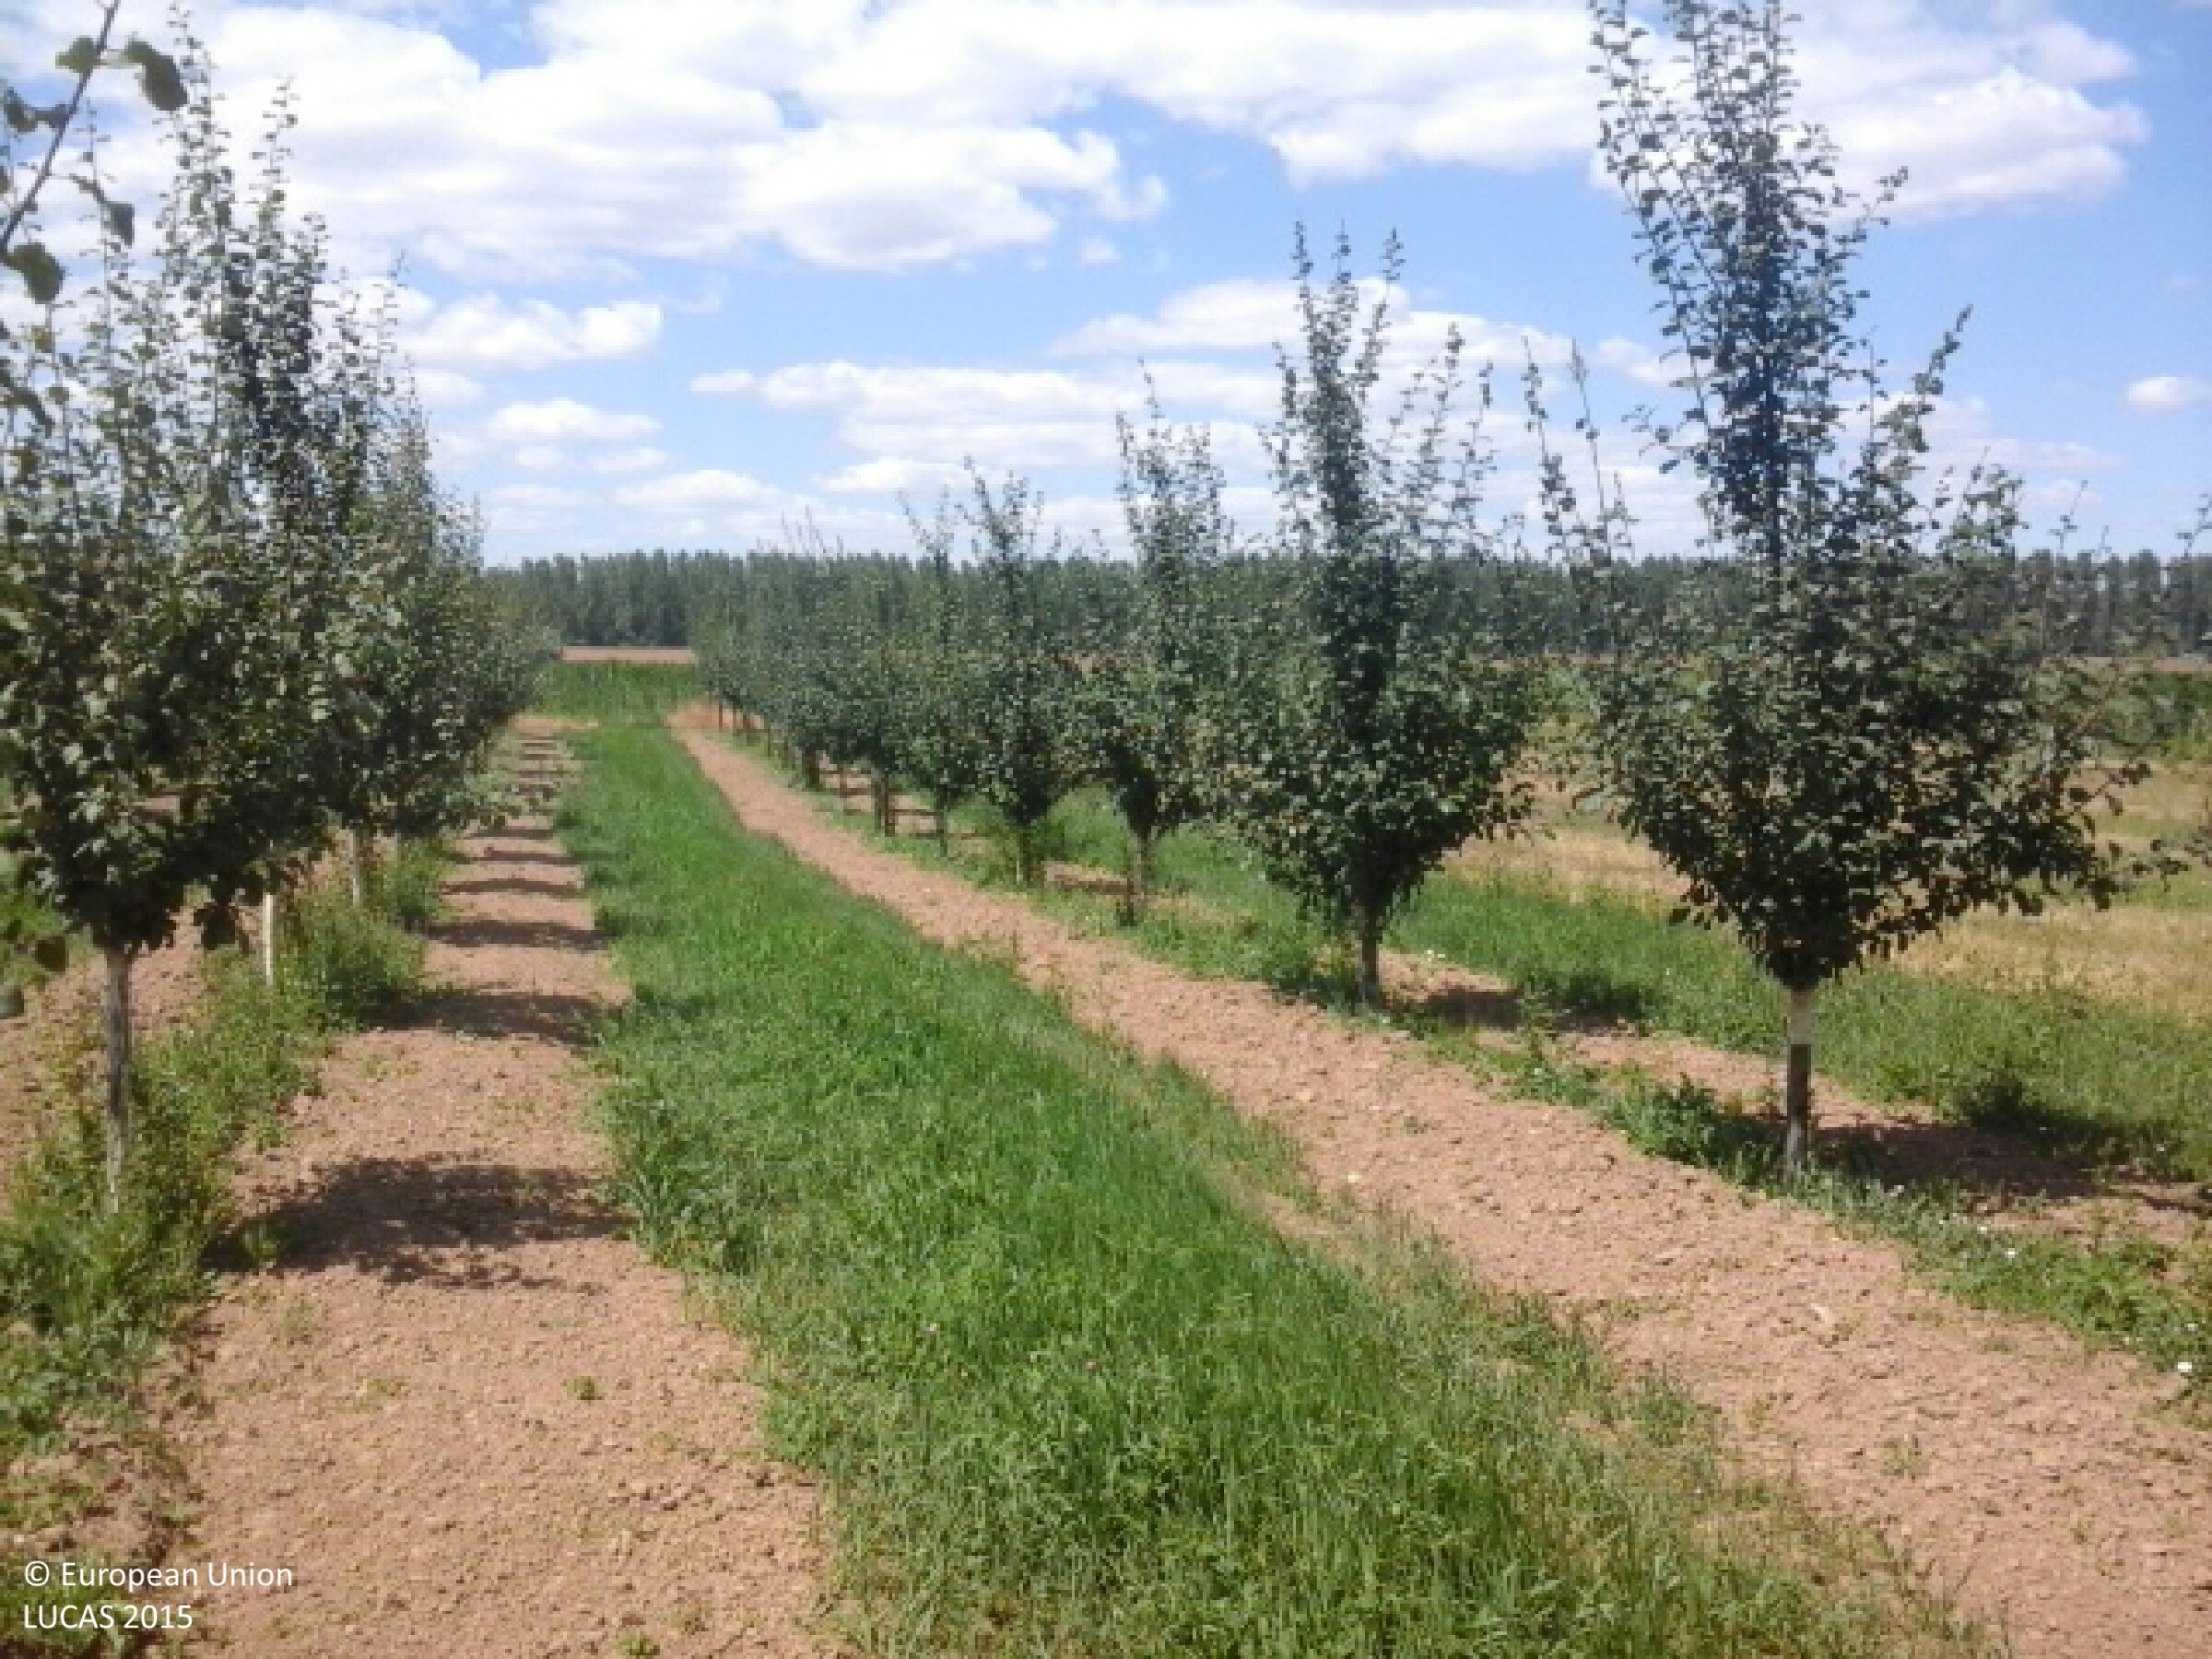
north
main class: Cropland
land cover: Other fruit trees and berries
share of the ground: 10 - 25 %
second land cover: Grassland without tree/shrub cover
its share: > 75 %
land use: Agriculture (excluding fallow land and kitchen gardens)
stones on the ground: < 10 %
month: July
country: HU
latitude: 48.2919
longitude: 22.0090
